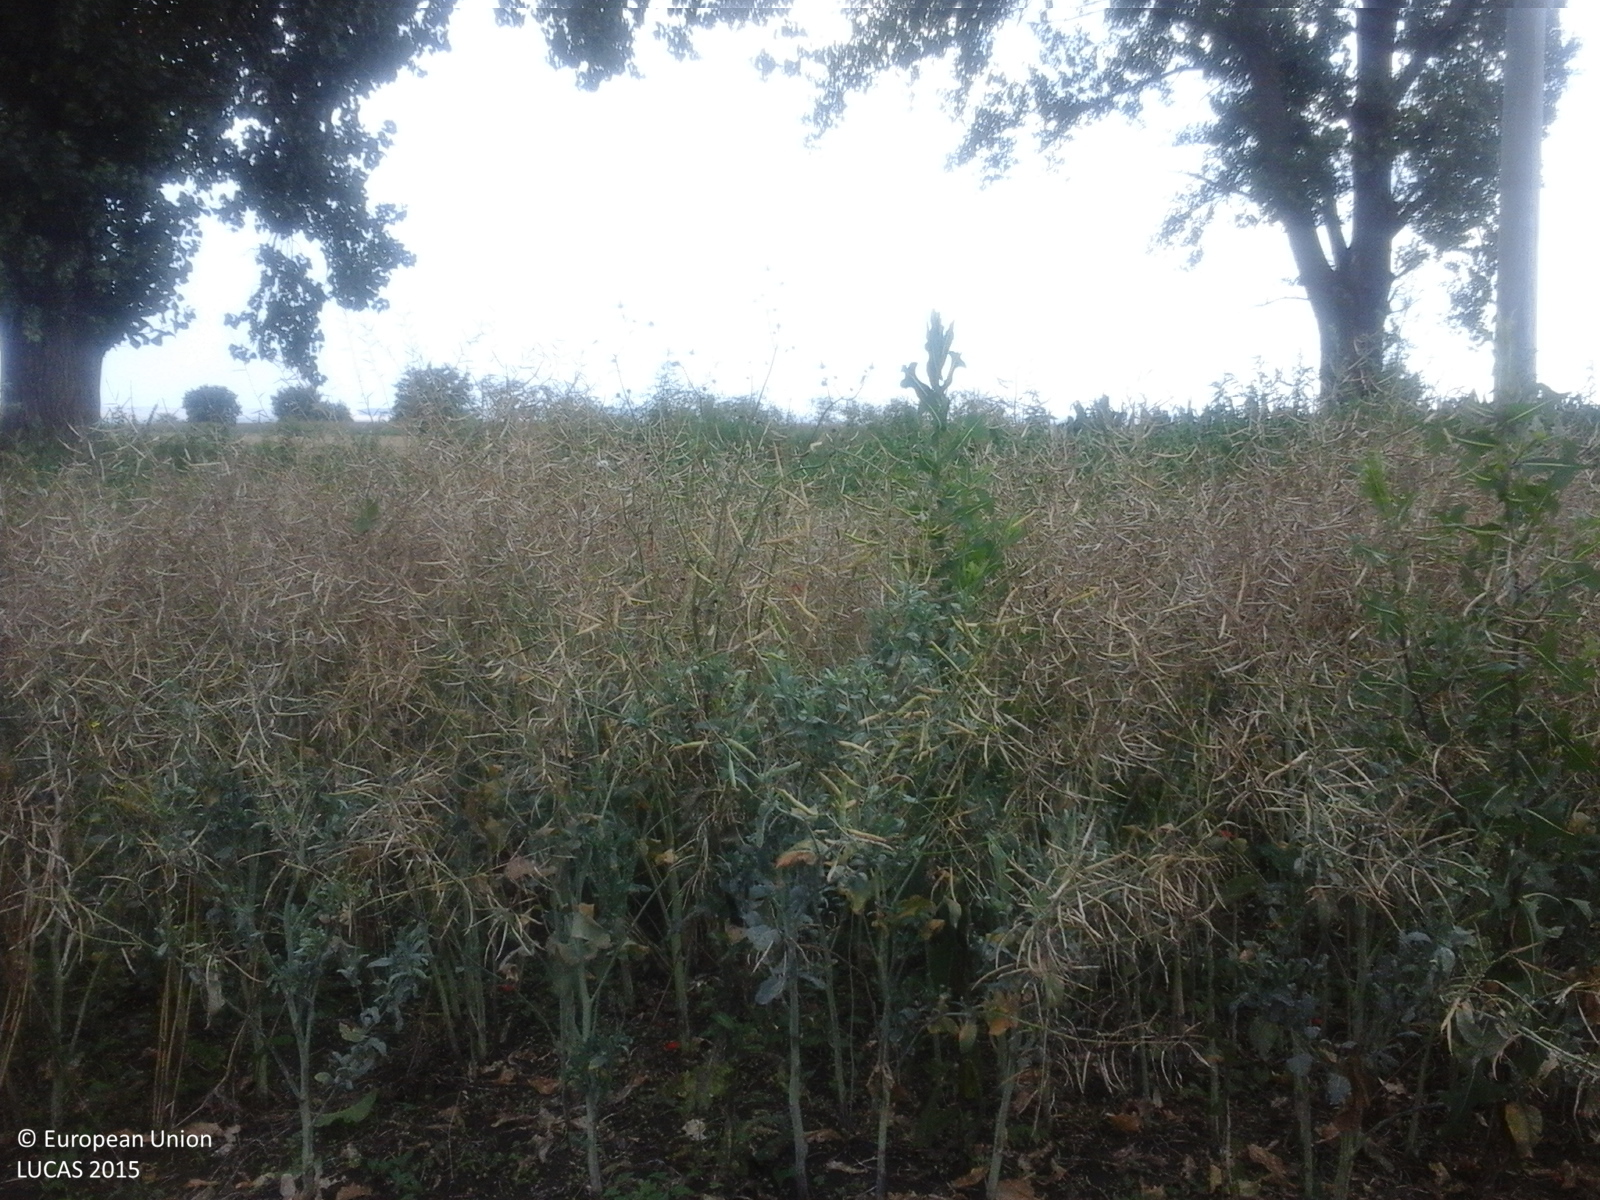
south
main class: Cropland
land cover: Maize
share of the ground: 50 - 75 %
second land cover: Other fresh vegetables
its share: 25 - 50 %
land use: Agriculture (excluding fallow land and kitchen gardens)
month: July
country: RO
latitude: 43.7345
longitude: 25.6948
